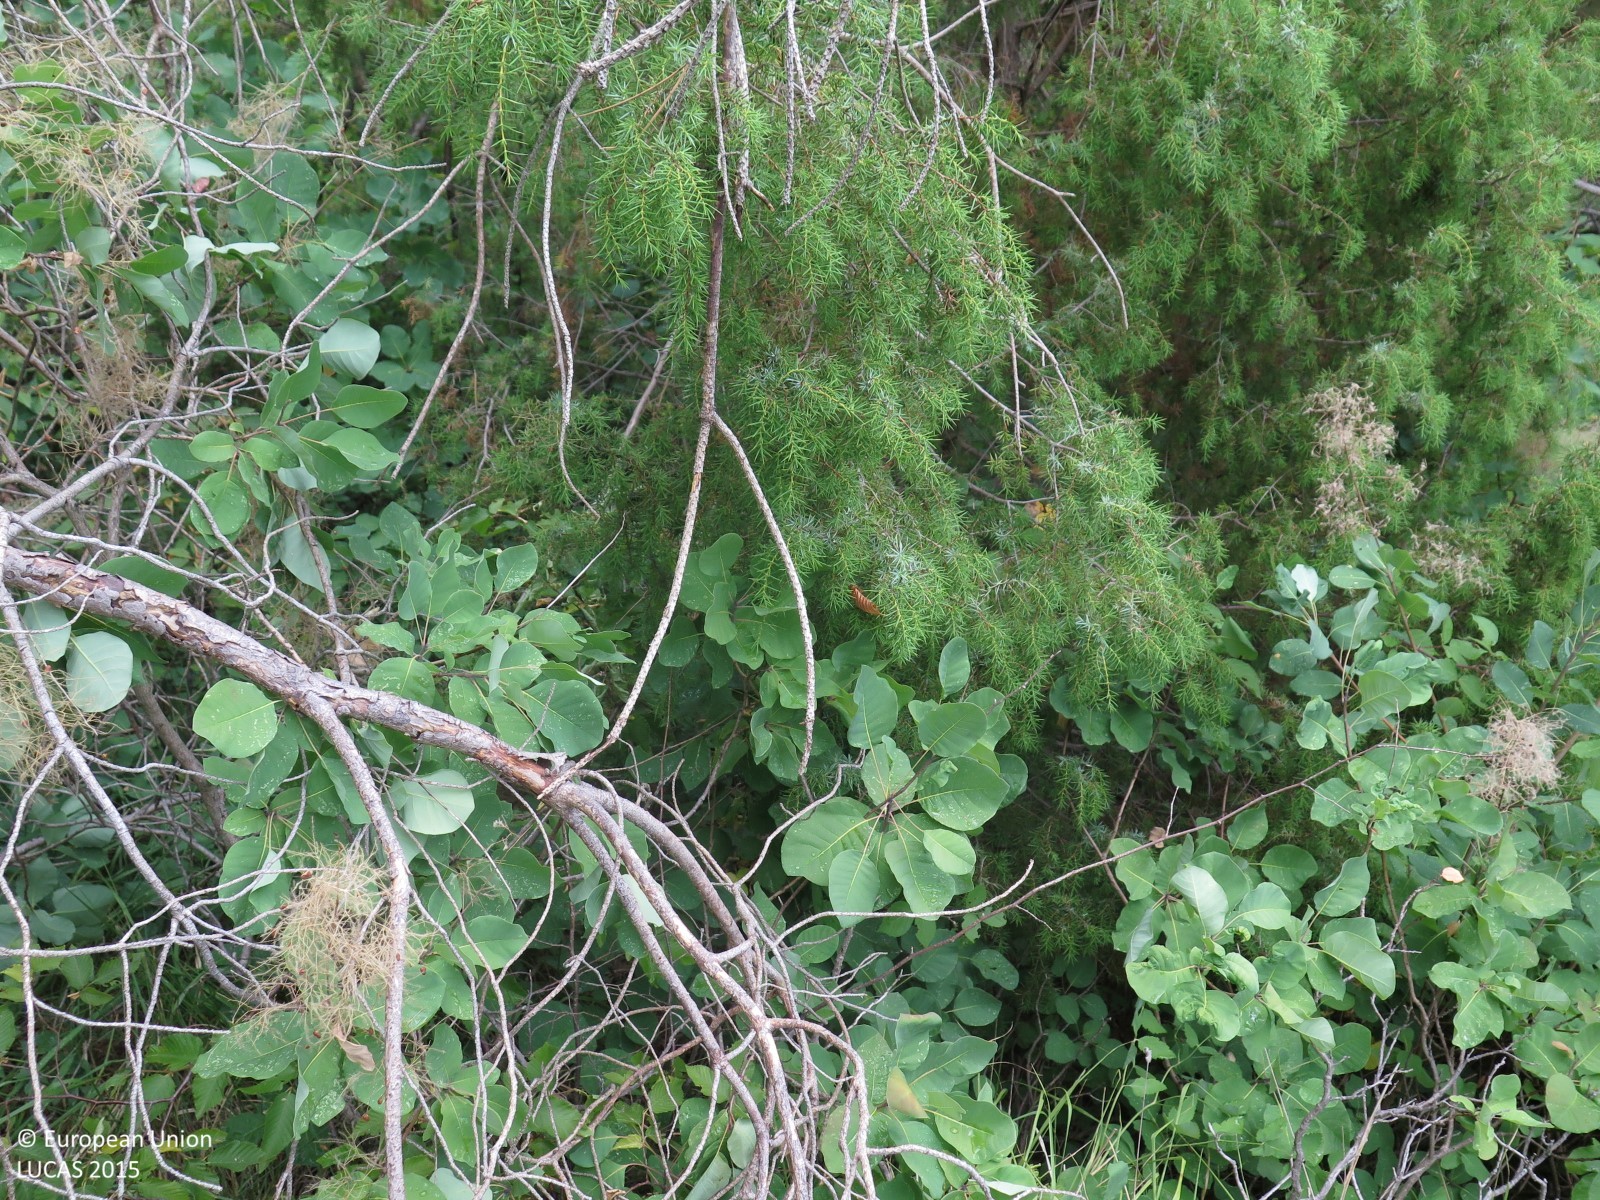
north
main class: Woodland
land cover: Other mixed woodland
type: coniferous forest of the mediterranean region
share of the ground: > 75 %
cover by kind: broadleaved forest trees 75 %, coniferous forest trees 25 %
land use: Semi-natural and natural areas not in use
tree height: < 5 m
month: July
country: HR
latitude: 45.2460
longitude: 14.0590
